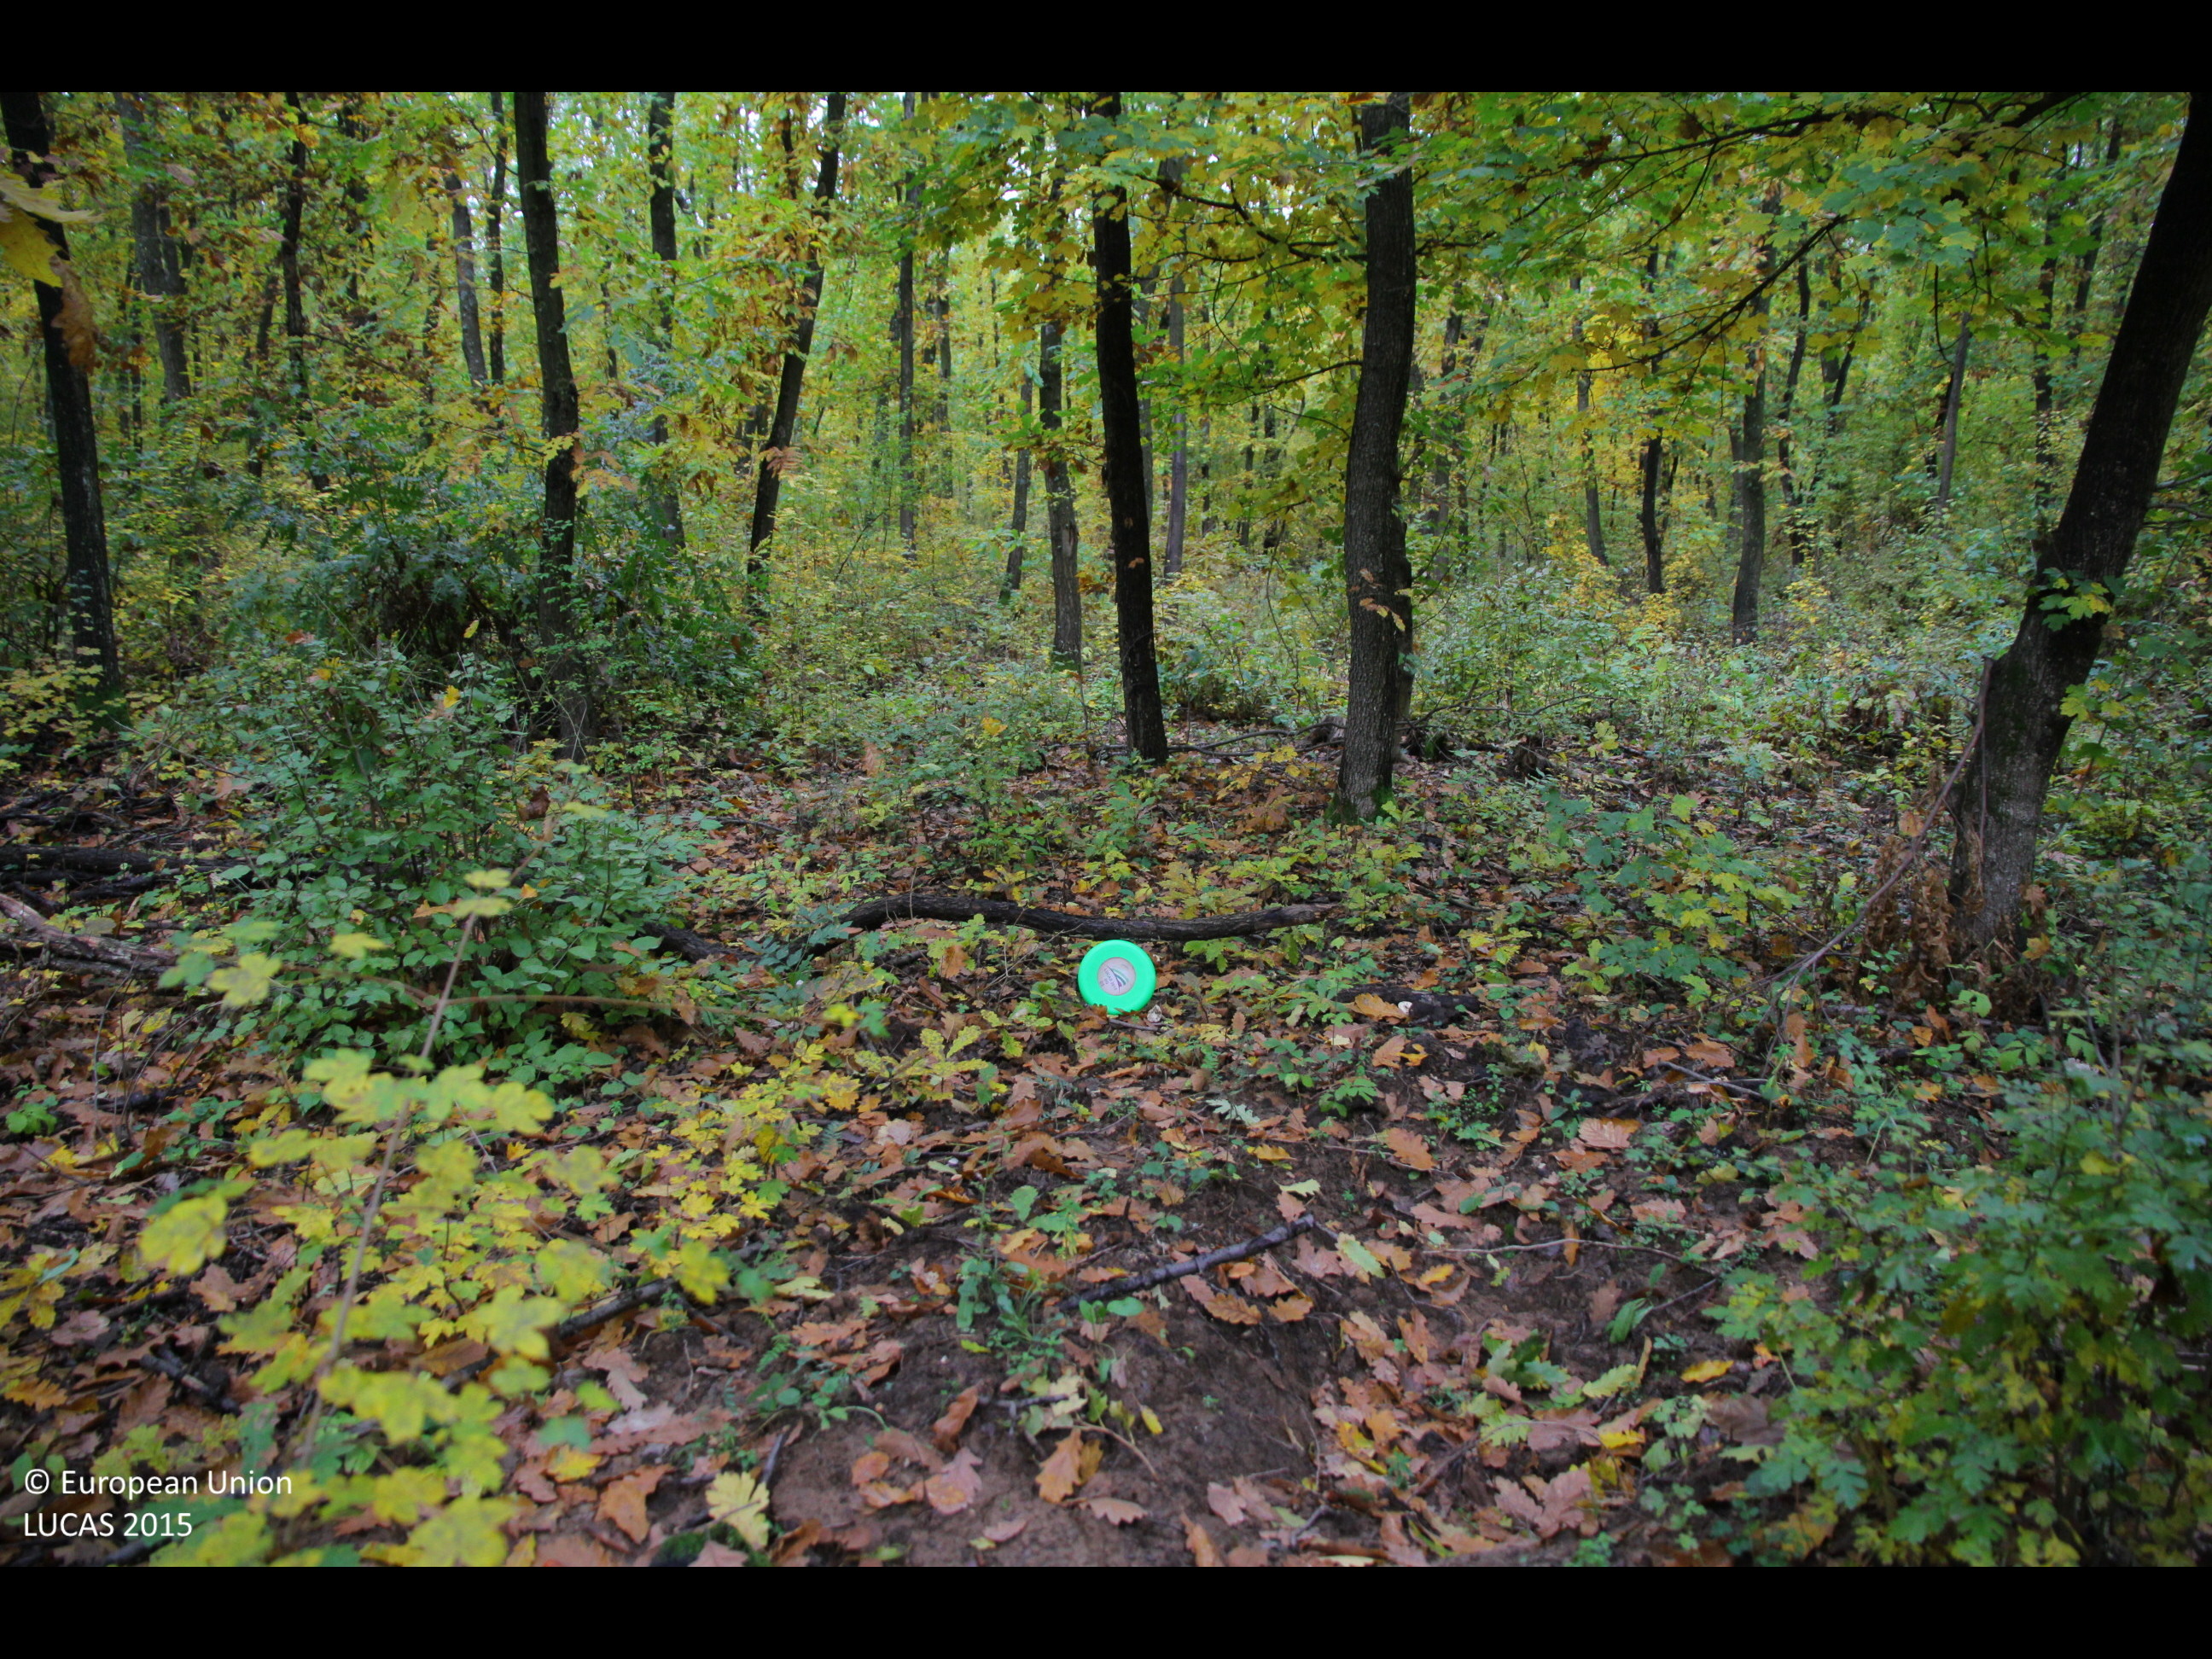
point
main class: Woodland
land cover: Broadleaved woodland
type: mesophytic deciduous forest
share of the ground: > 75 %
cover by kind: broadleaved forest trees 100 %
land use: Forestry
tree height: > 5 m
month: October
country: BG
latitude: 43.5299
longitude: 26.8554
